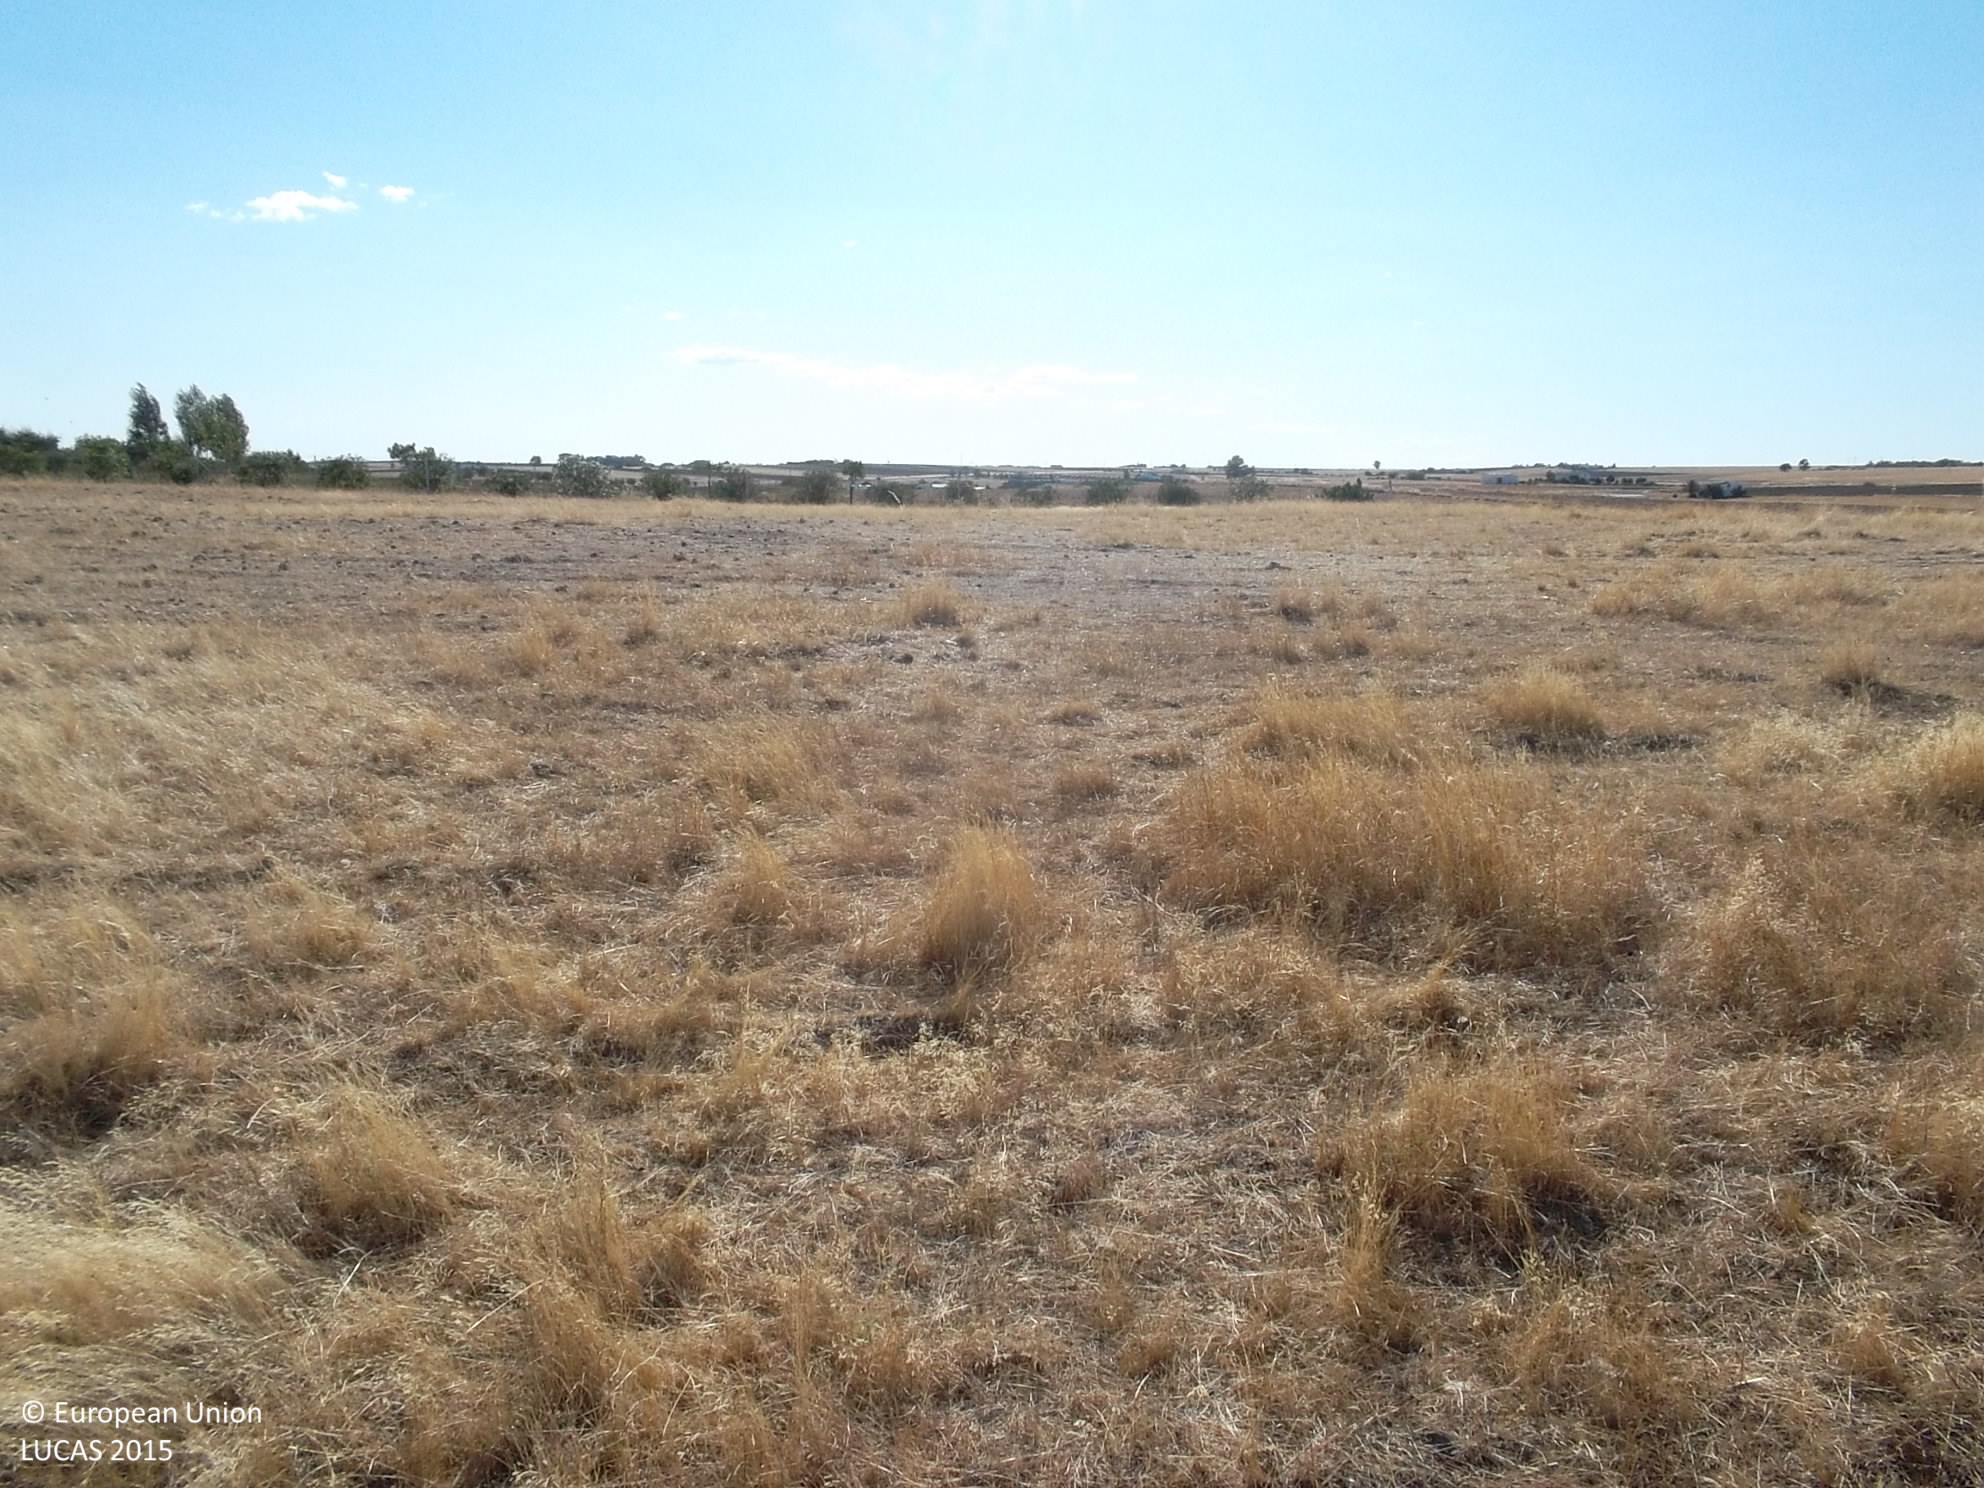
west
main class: Grassland
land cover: Spontaneously vegetated surfaces
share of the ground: > 75 %
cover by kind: herbaceous plants 100 %
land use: Agriculture (excluding fallow land and kitchen gardens)
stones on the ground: 10 - 25 %
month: July
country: ES
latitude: 38.2793
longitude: -5.6845
